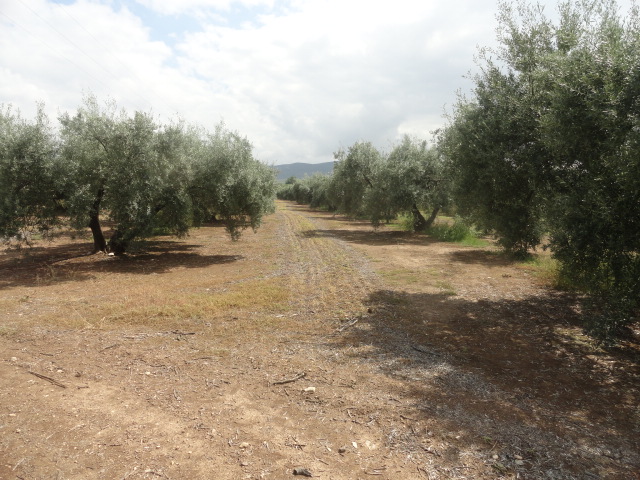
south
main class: Cropland
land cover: Olive groves
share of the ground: 50 - 75 %
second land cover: Spontaneously vegetated surfaces
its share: 25 - 50 %
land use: Agriculture (excluding fallow land and kitchen gardens)
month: April
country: ES
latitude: 37.6162
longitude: -4.5421
